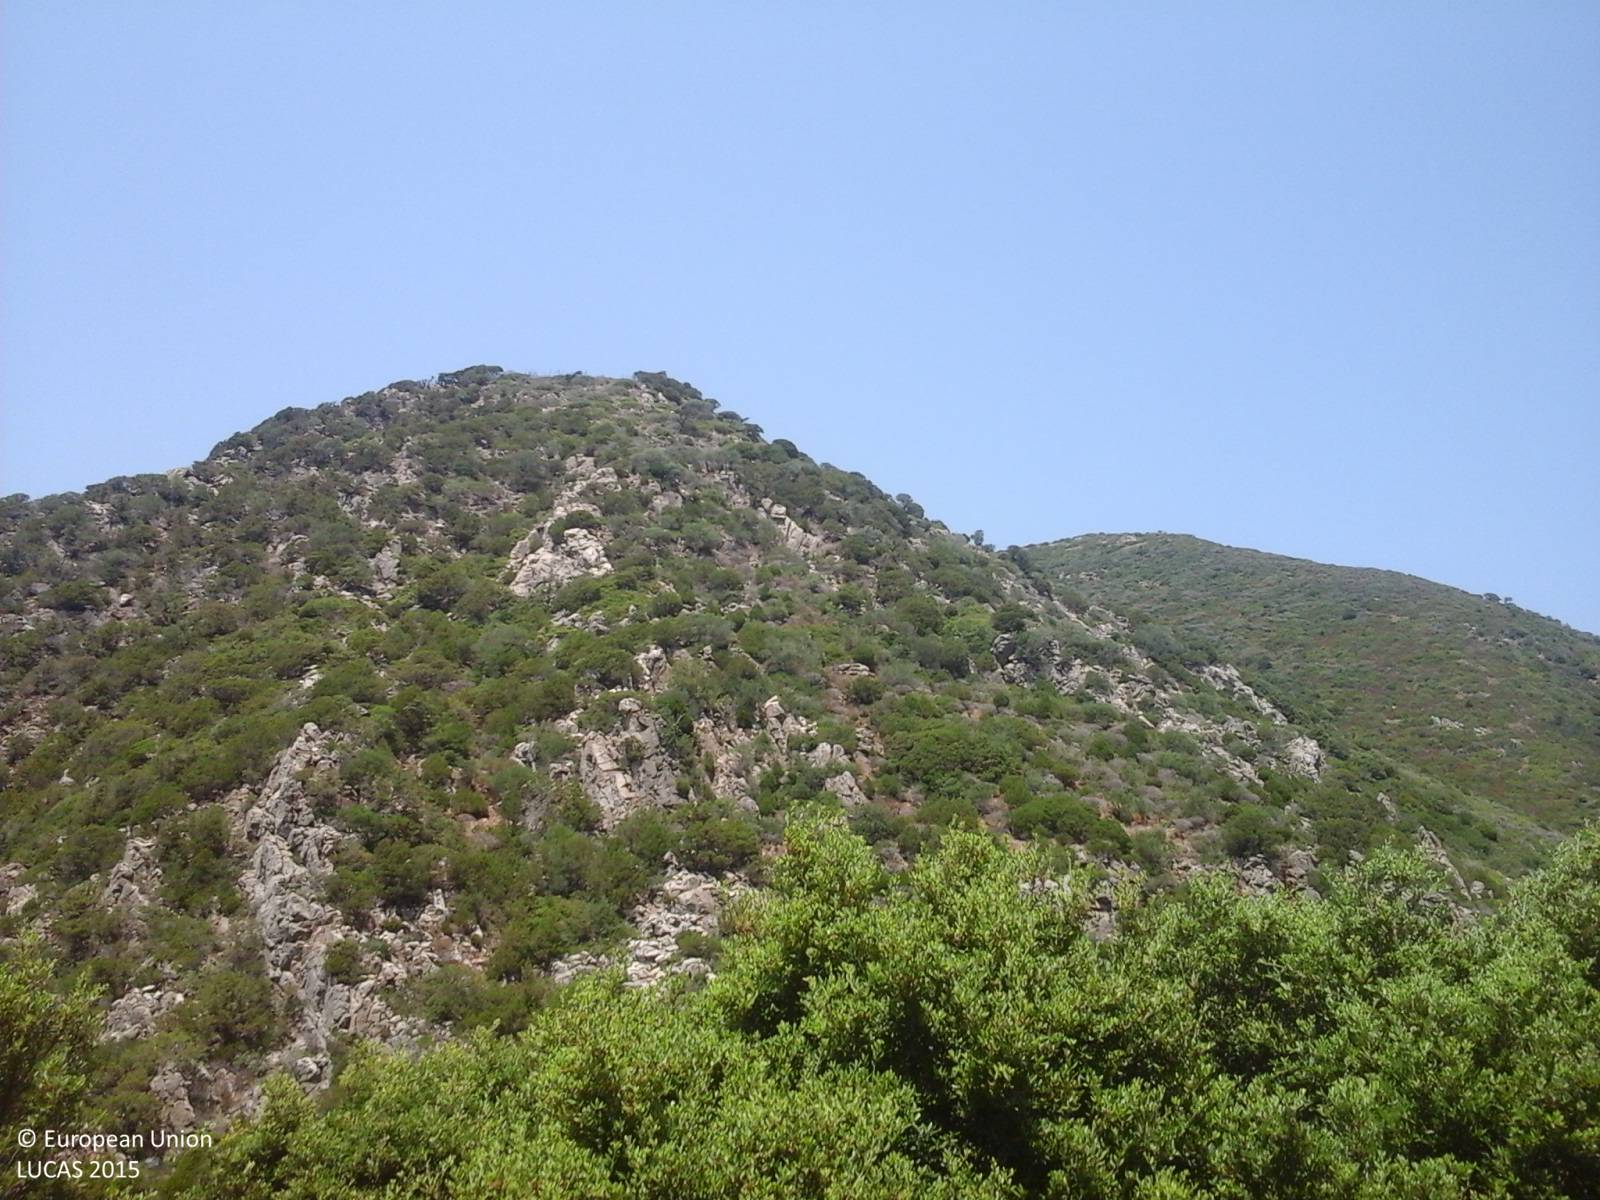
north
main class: Woodland
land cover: Broadleaved woodland
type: broadleaved evergreen forest
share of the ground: > 75 %
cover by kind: broadleaved forest trees 60 %, shrubs 25 %, herbaceous plants 10 %, consolidated bare surface 5 %
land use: Semi-natural and natural areas not in use
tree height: > 5 m
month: July
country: IT
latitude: 39.3312
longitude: 8.4433
